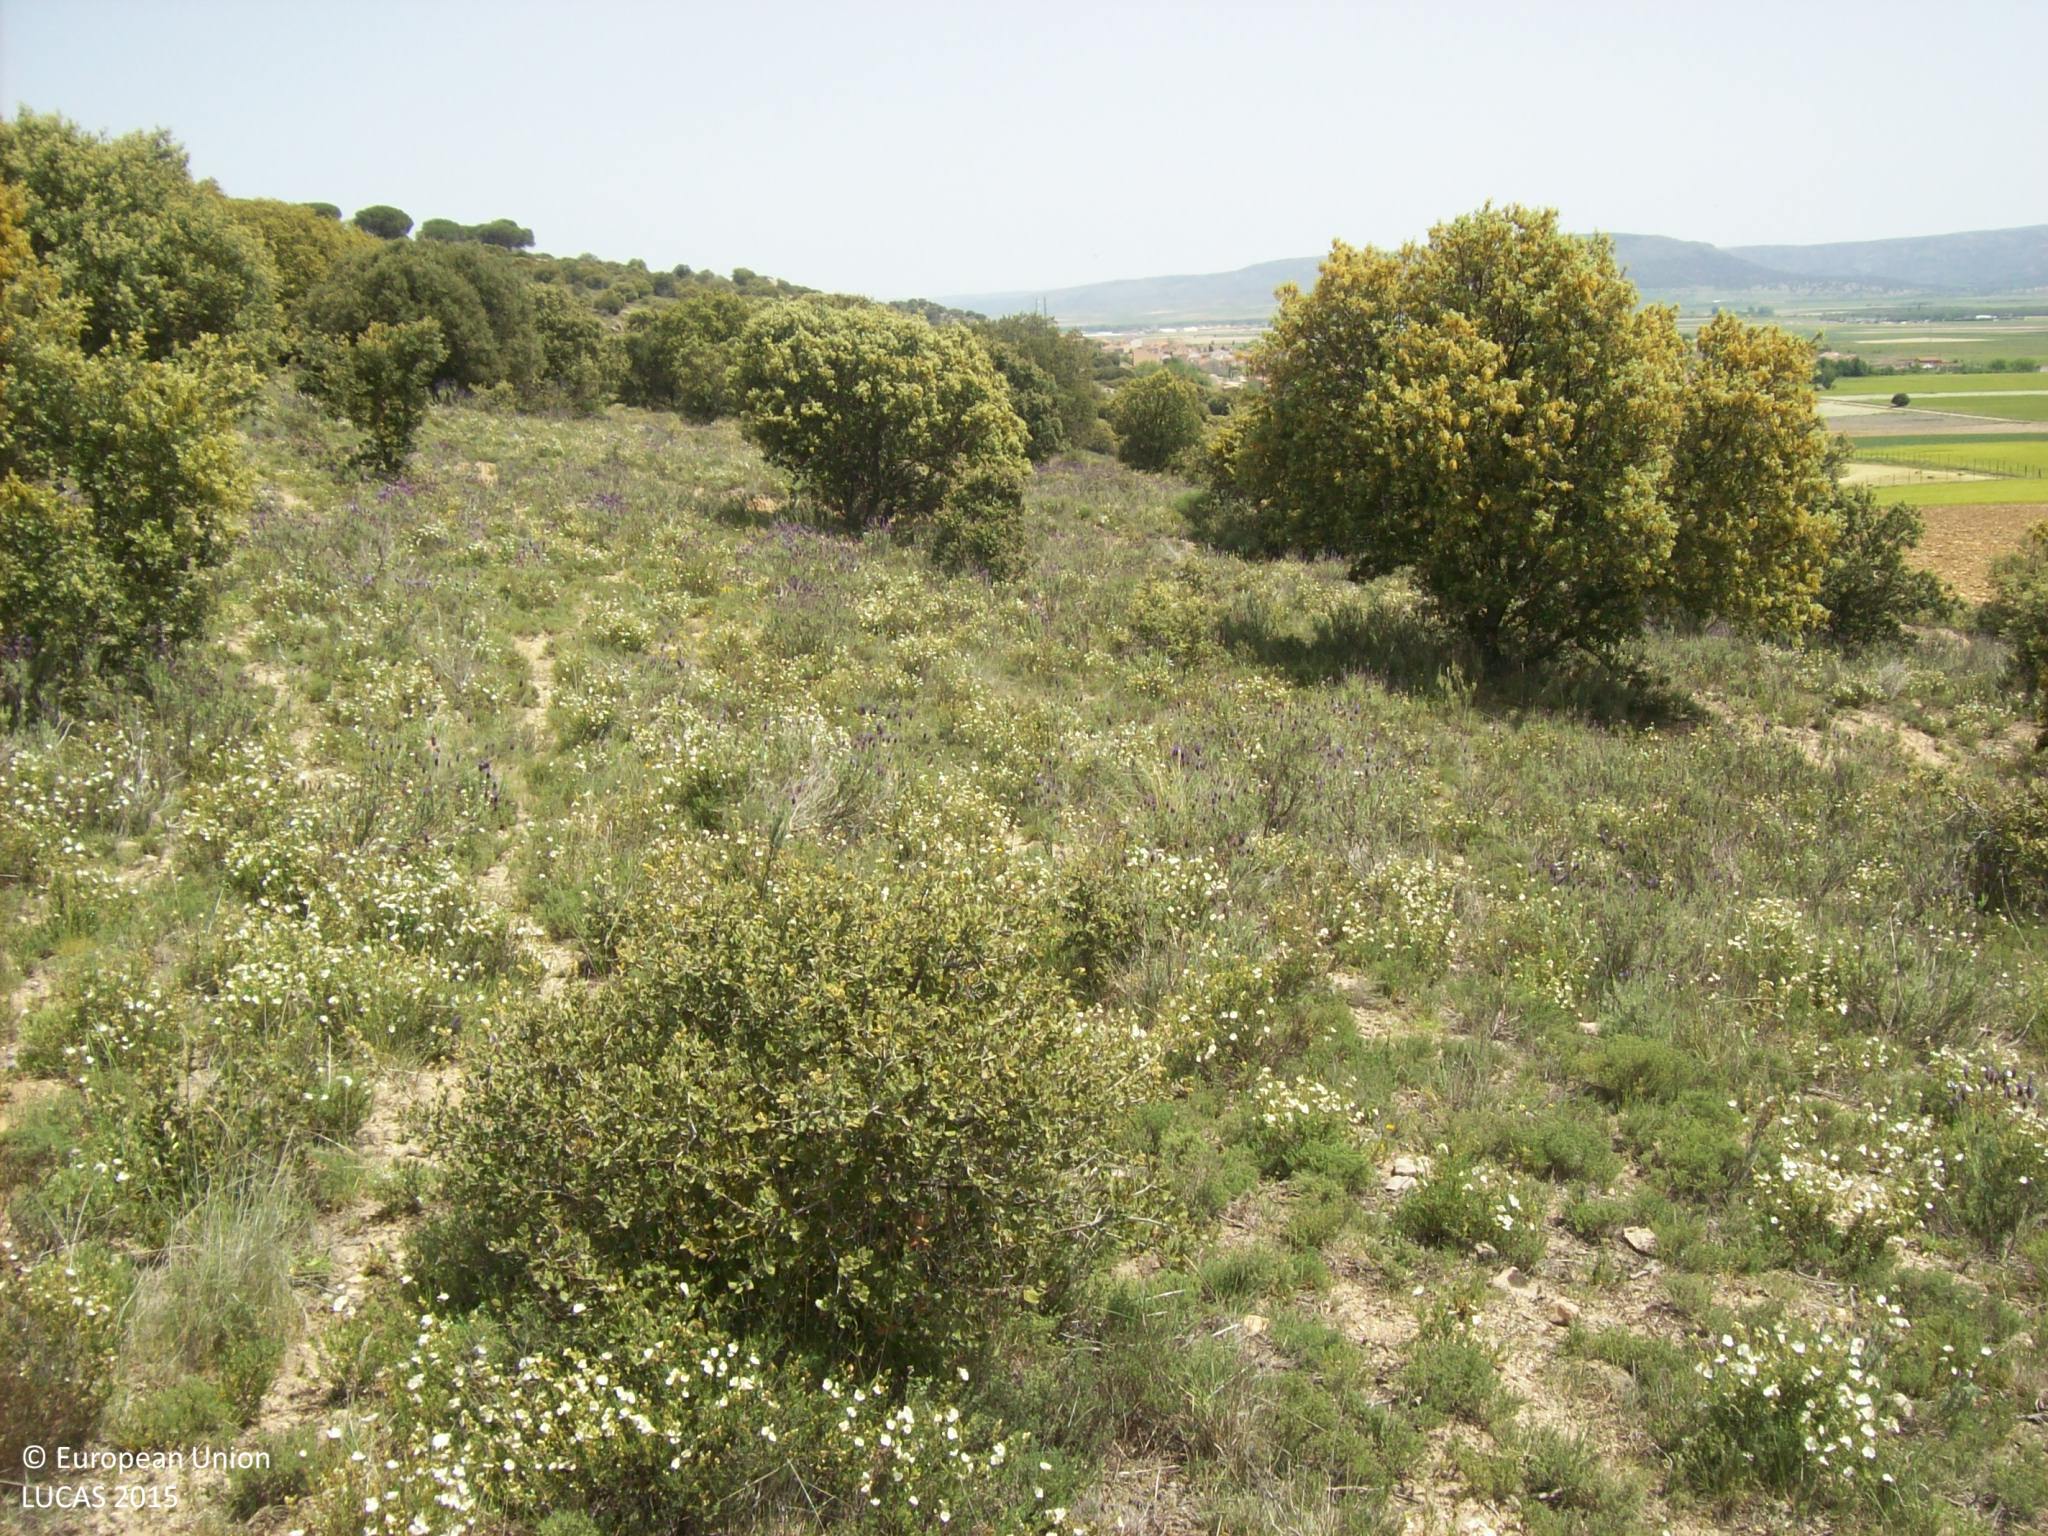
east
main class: Woodland
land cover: Broadleaved woodland
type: broadleaved evergreen forest
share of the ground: 50 - 75 %
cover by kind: shrubs 60 %, unconsolidated bare surface 20 %, broadleaved forest trees 10 %, herbaceous plants 10 %
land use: Semi-natural and natural areas not in use
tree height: < 5 m
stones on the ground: < 10 %
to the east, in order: Broadleaved woodland; Rock outcrops; Broadleaved woodland; Rocks and stones
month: May
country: ES
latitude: 40.6072
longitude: -4.9144
